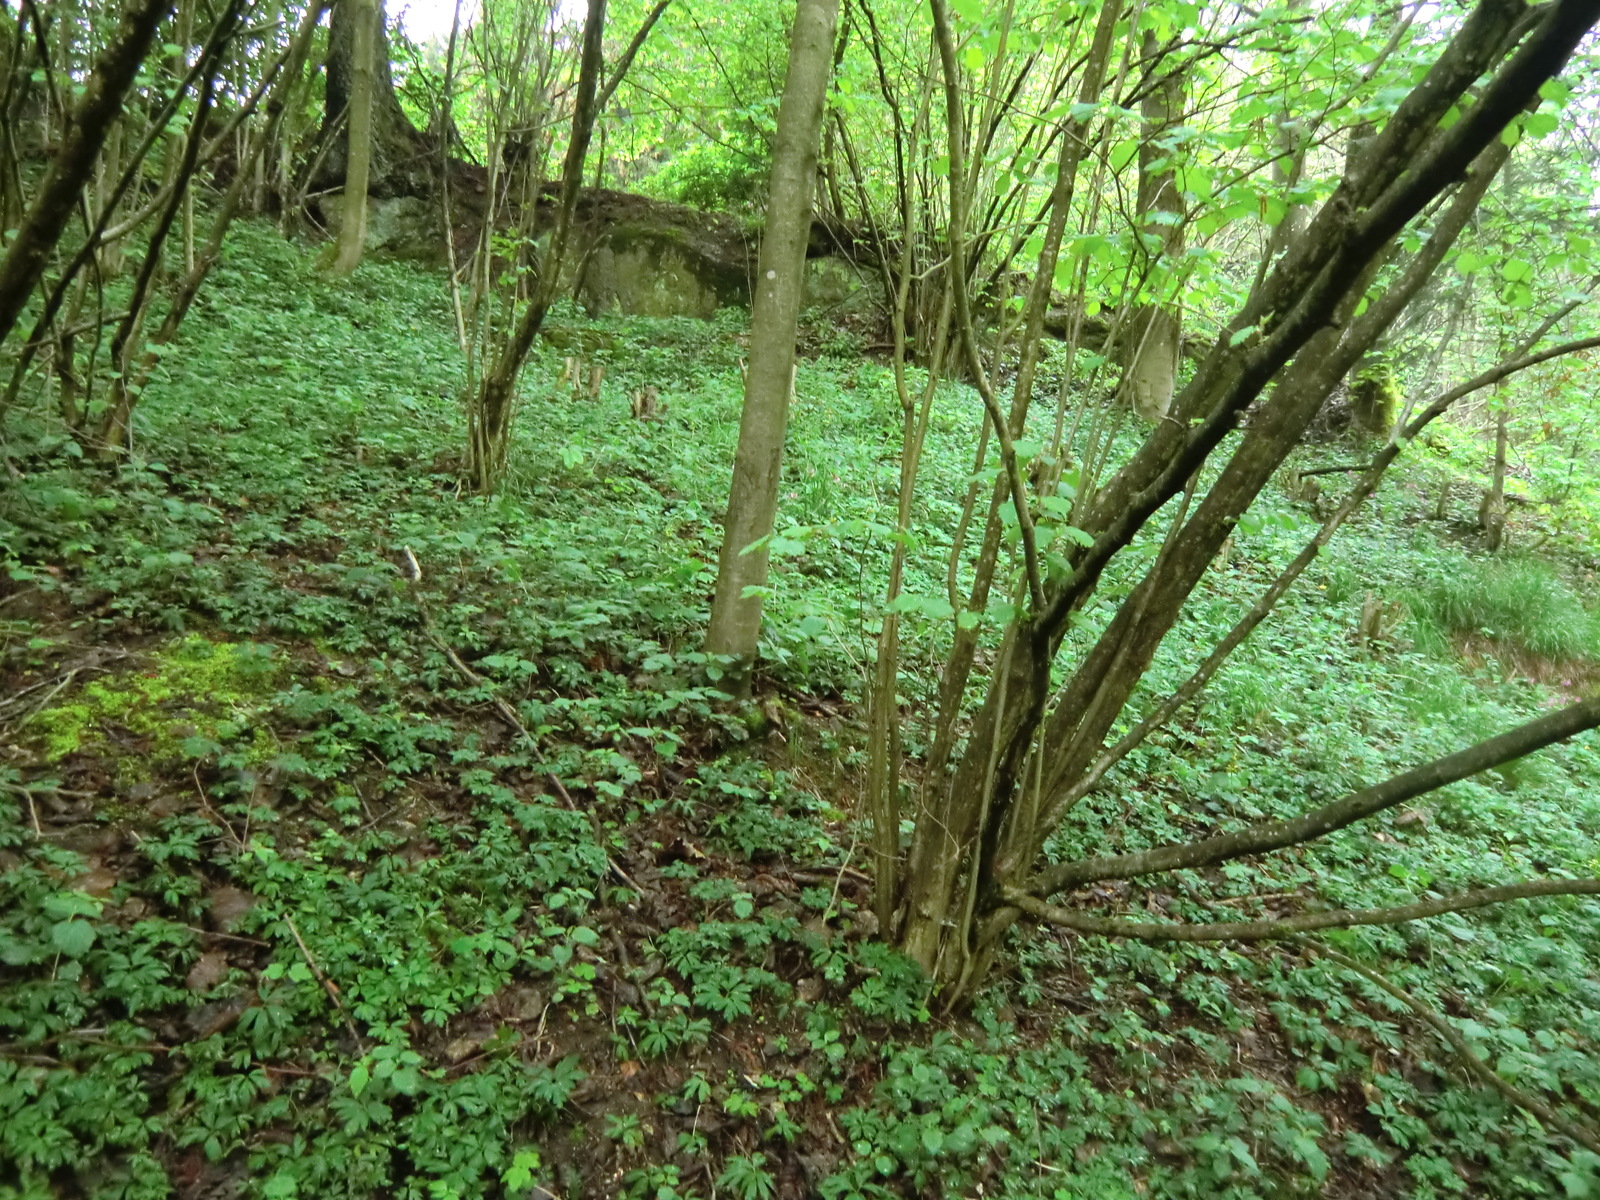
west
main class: Woodland
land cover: Broadleaved woodland
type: hemiboreal forest and nemoral coniferous forest and mixed broadleaved-coniferous forest
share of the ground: > 75 %
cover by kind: broadleaved forest trees 55 %, herbaceous plants 30 %, unconsolidated bare surface 10 %, coniferous forest trees 5 %
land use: Forestry
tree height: > 5 m
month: May
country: AT
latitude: 48.3213
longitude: 14.7075
